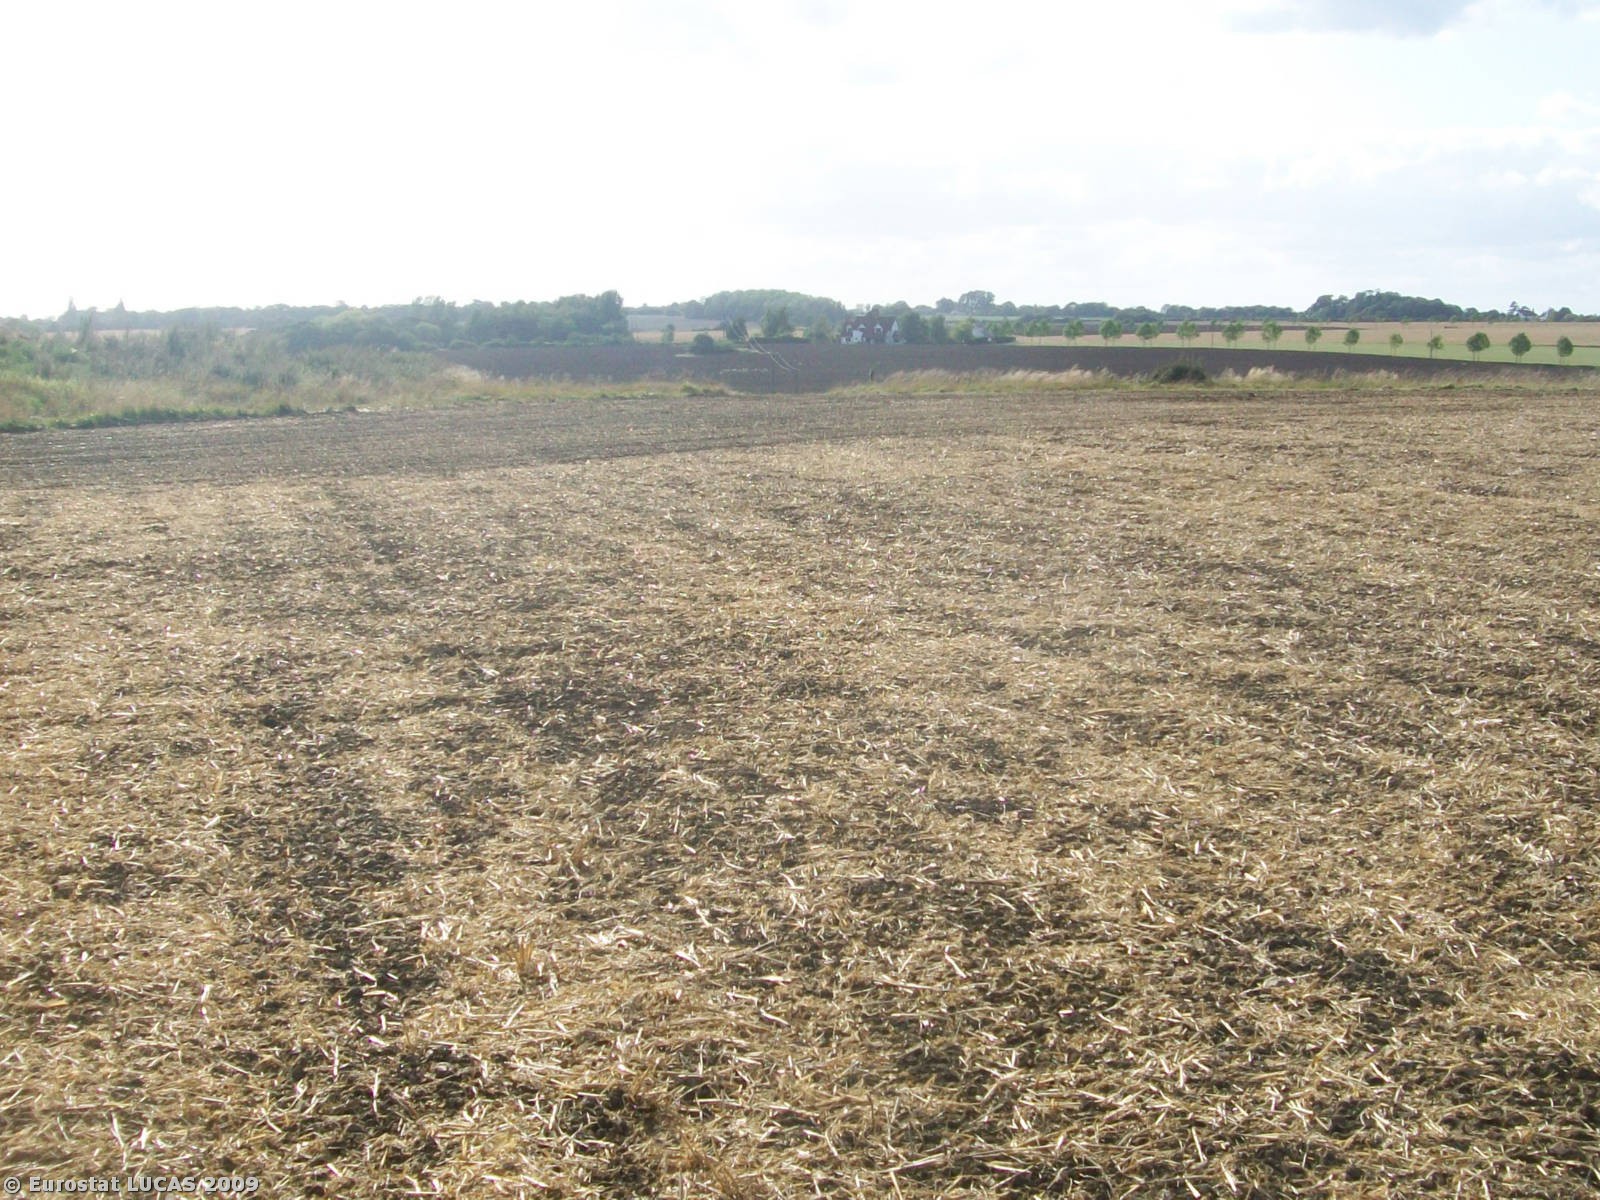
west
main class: Cropland
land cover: Common wheat
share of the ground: < 10 %
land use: Agriculture (excluding fallow land and kitchen gardens)
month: August
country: GB
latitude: 51.7279
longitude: 0.1088
